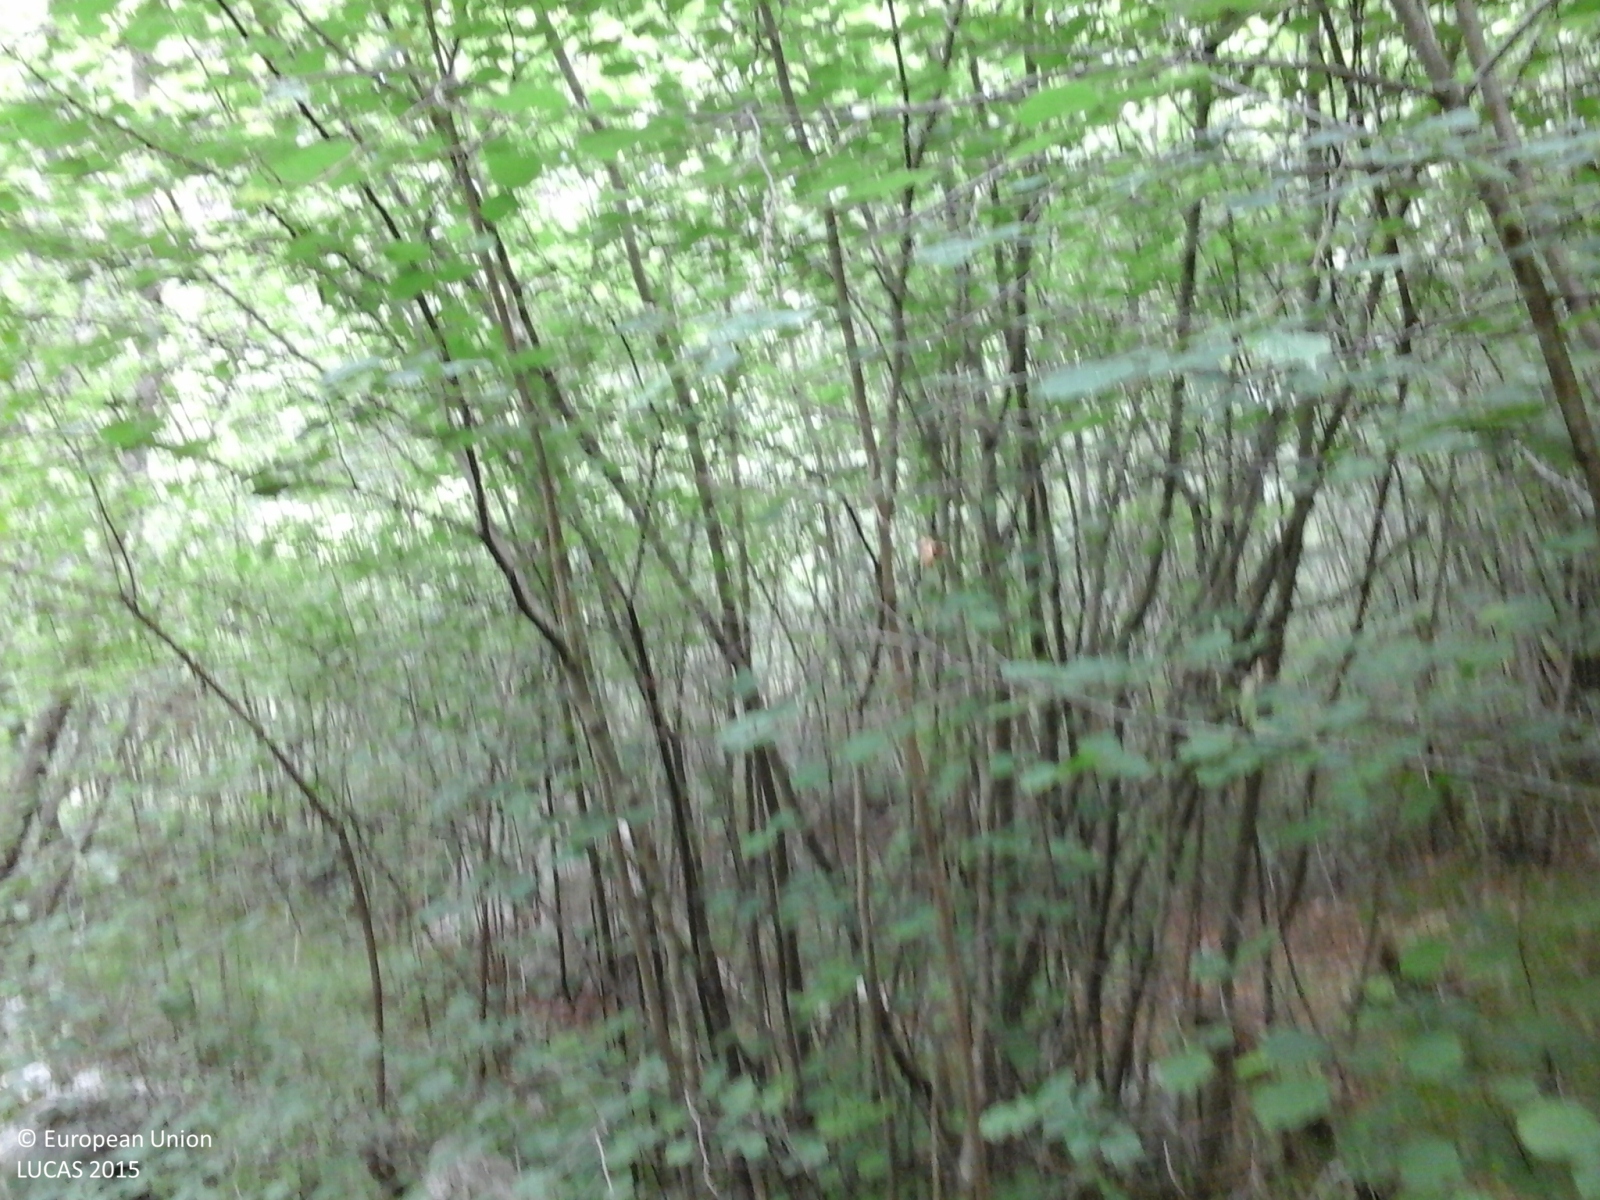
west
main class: Woodland
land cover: Broadleaved woodland
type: thermophilous deciduous forest
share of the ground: > 75 %
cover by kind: broadleaved forest trees 90 %, coniferous forest trees 10 %
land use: Semi-natural and natural areas not in use
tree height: > 5 m
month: June
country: IT
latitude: 46.1820
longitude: 12.3161
